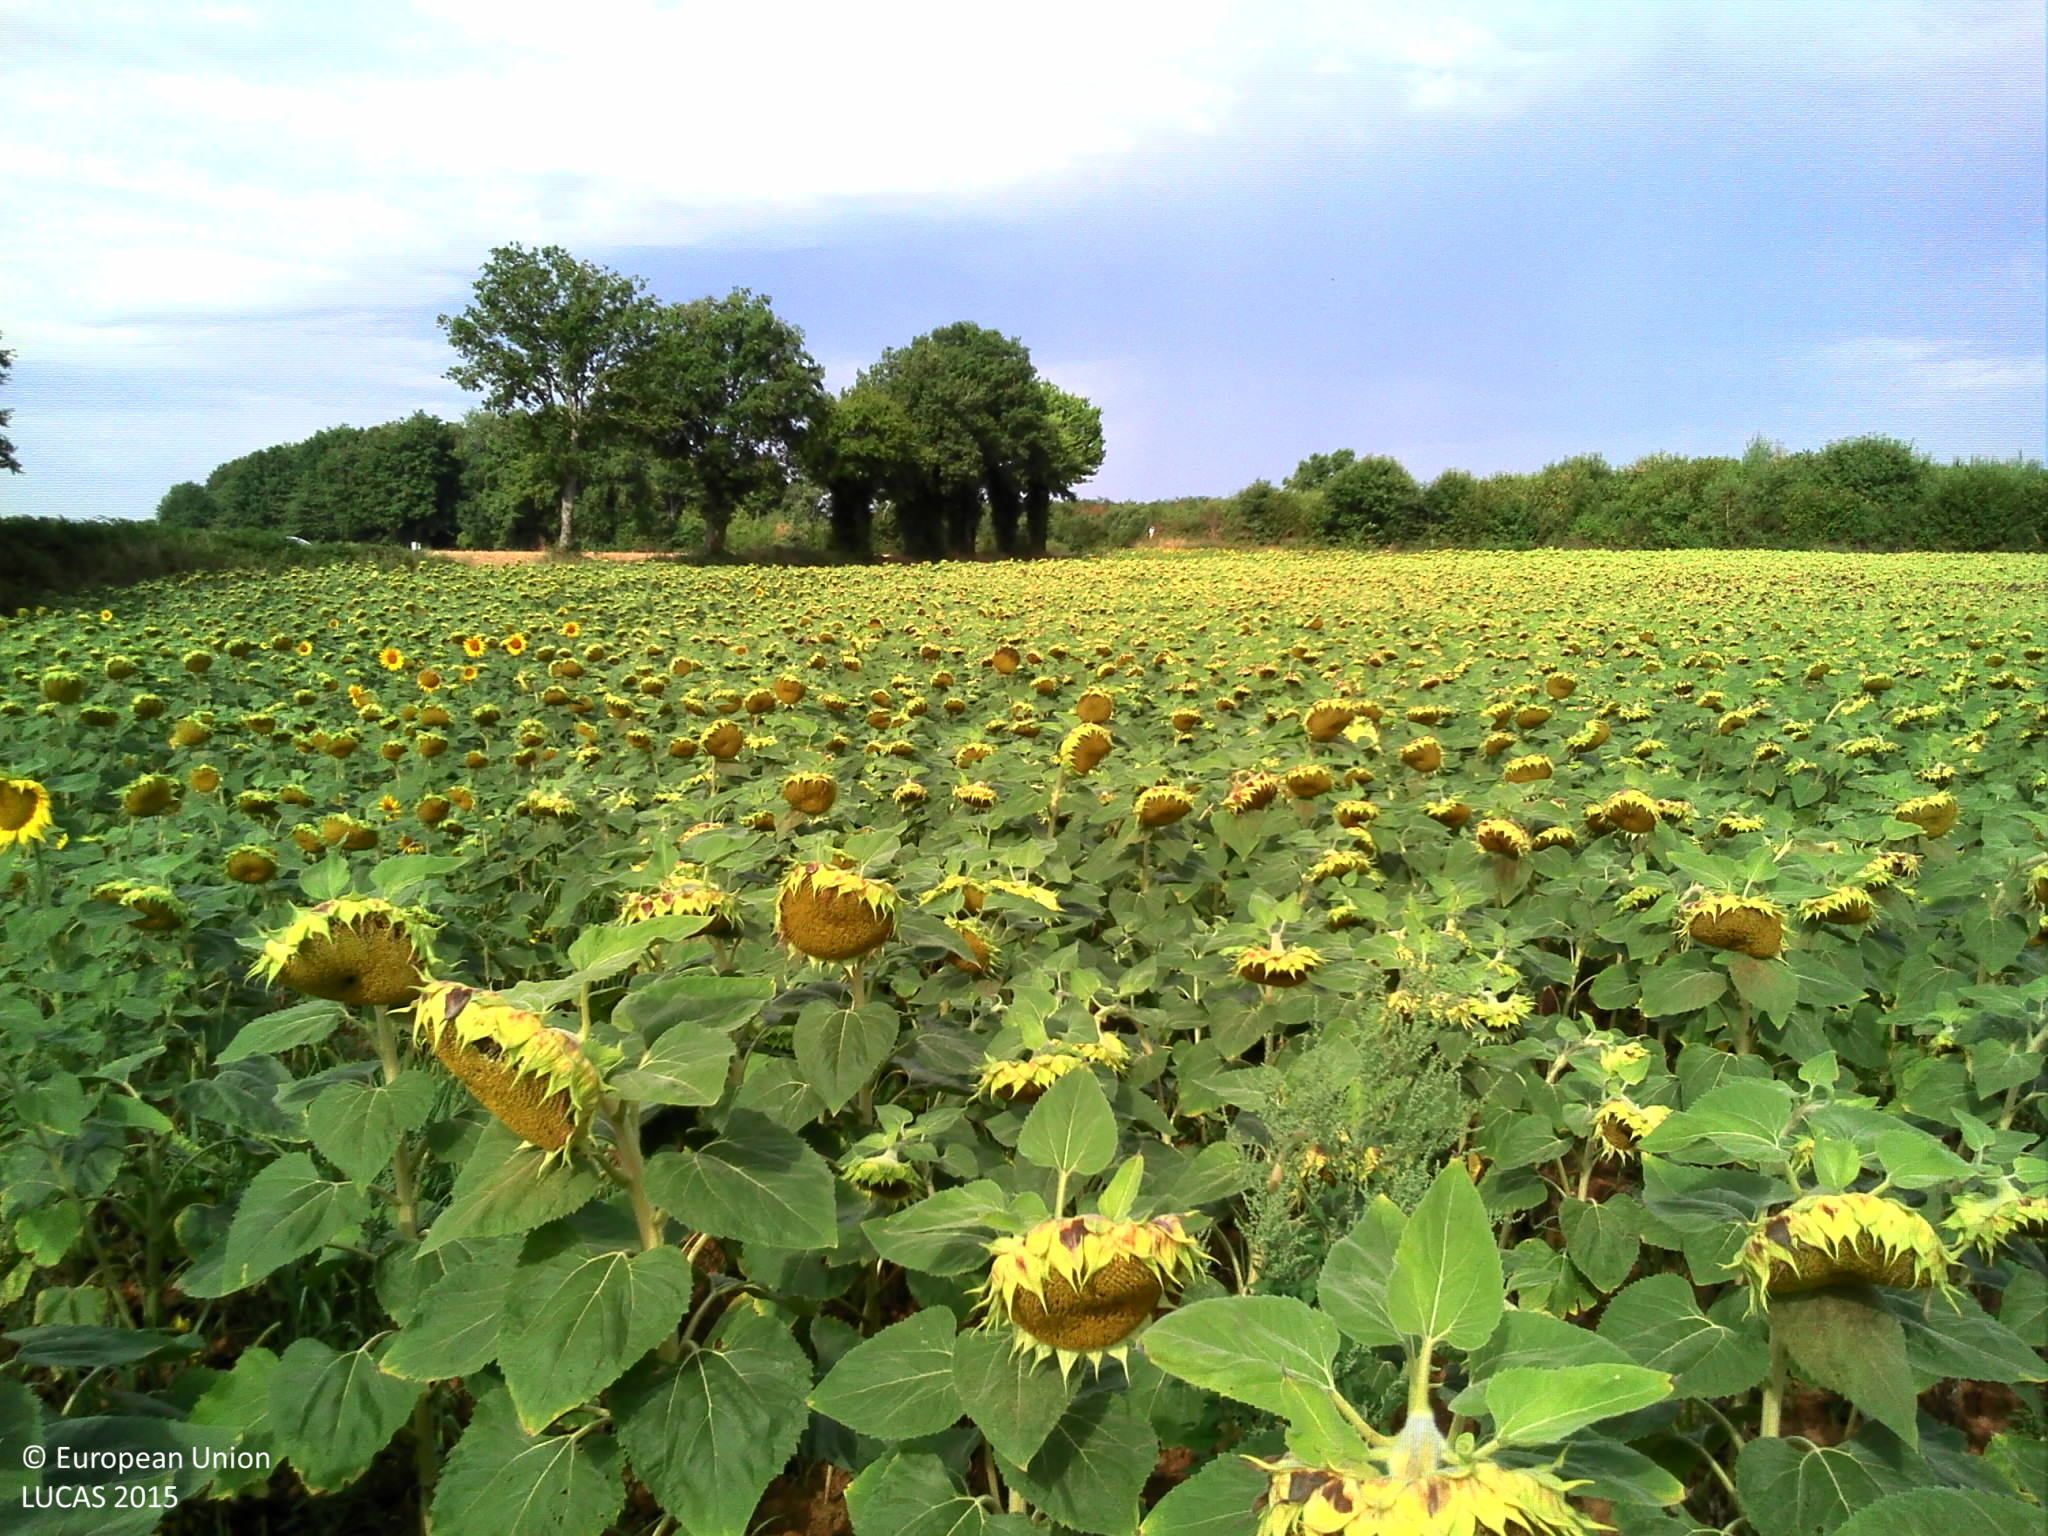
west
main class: Cropland
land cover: Sunflower
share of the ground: > 75 %
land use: Agriculture (excluding fallow land and kitchen gardens)
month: August
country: FR
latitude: 46.1865
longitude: 0.3564
